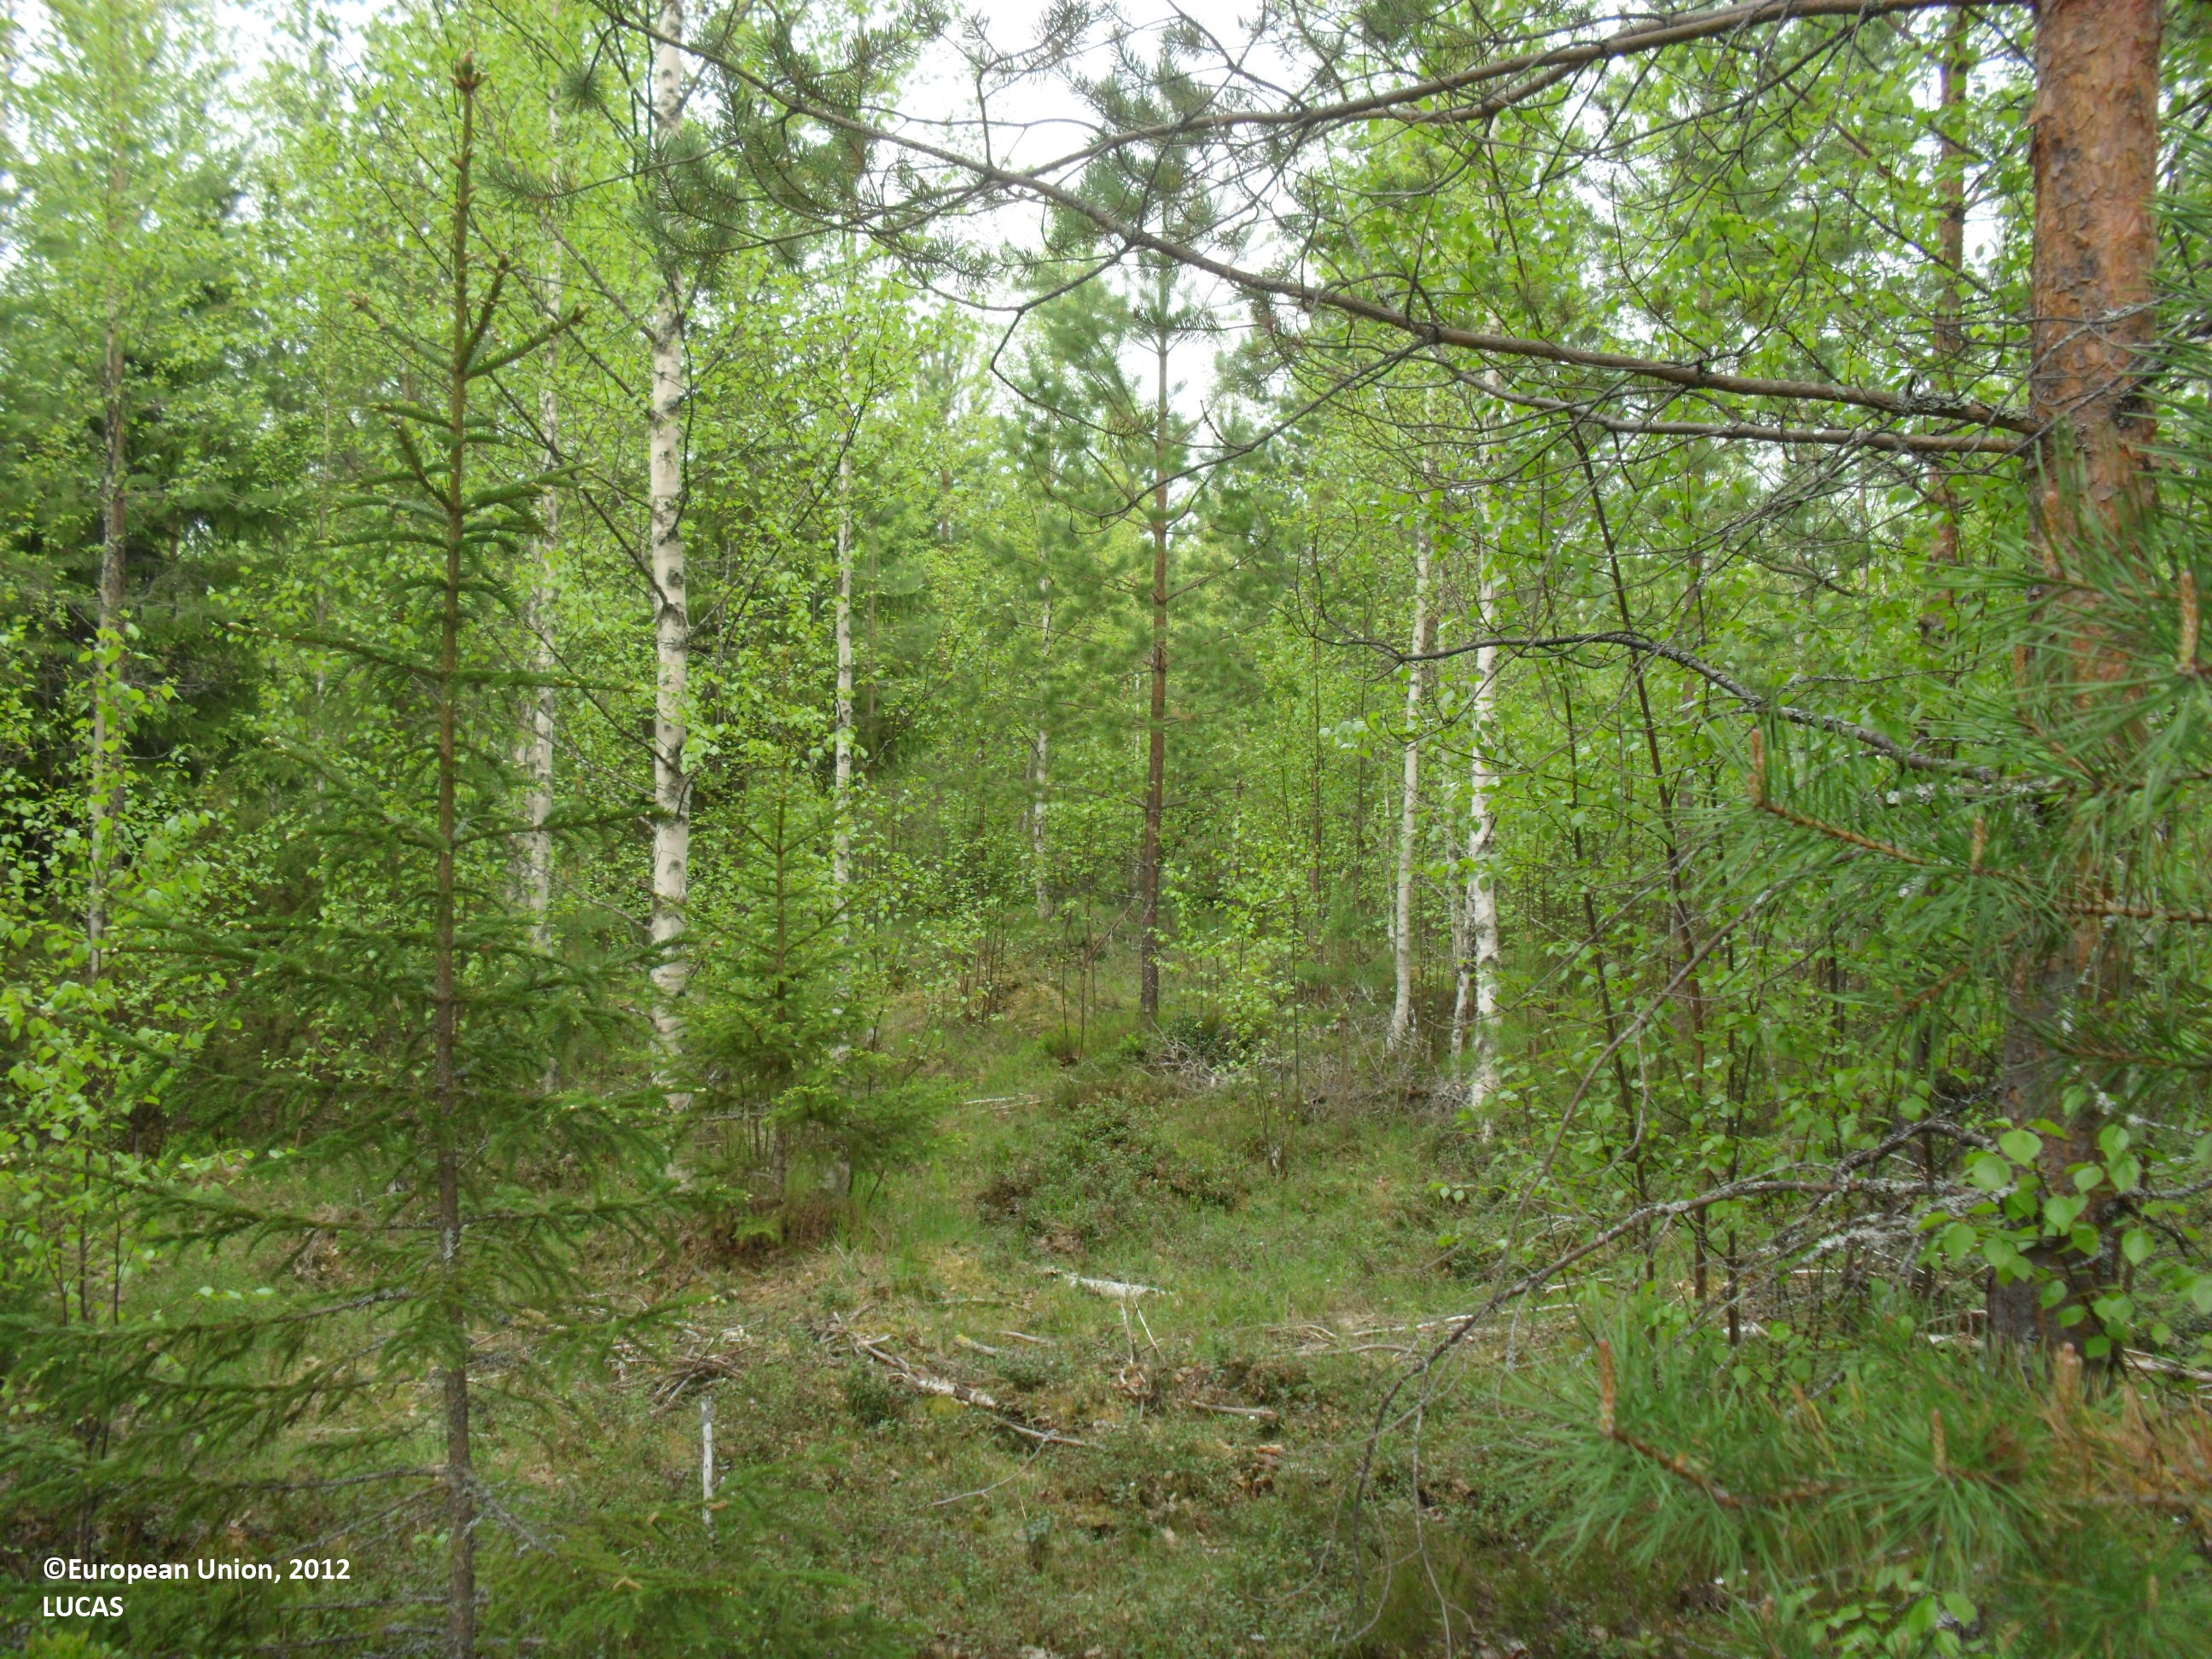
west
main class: Woodland
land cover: Pine dominated mixed woodland
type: boreal forest
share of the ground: 50 - 75 %
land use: Forestry
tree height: > 5 m
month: June
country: FI
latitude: 63.0172
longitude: 22.9982
